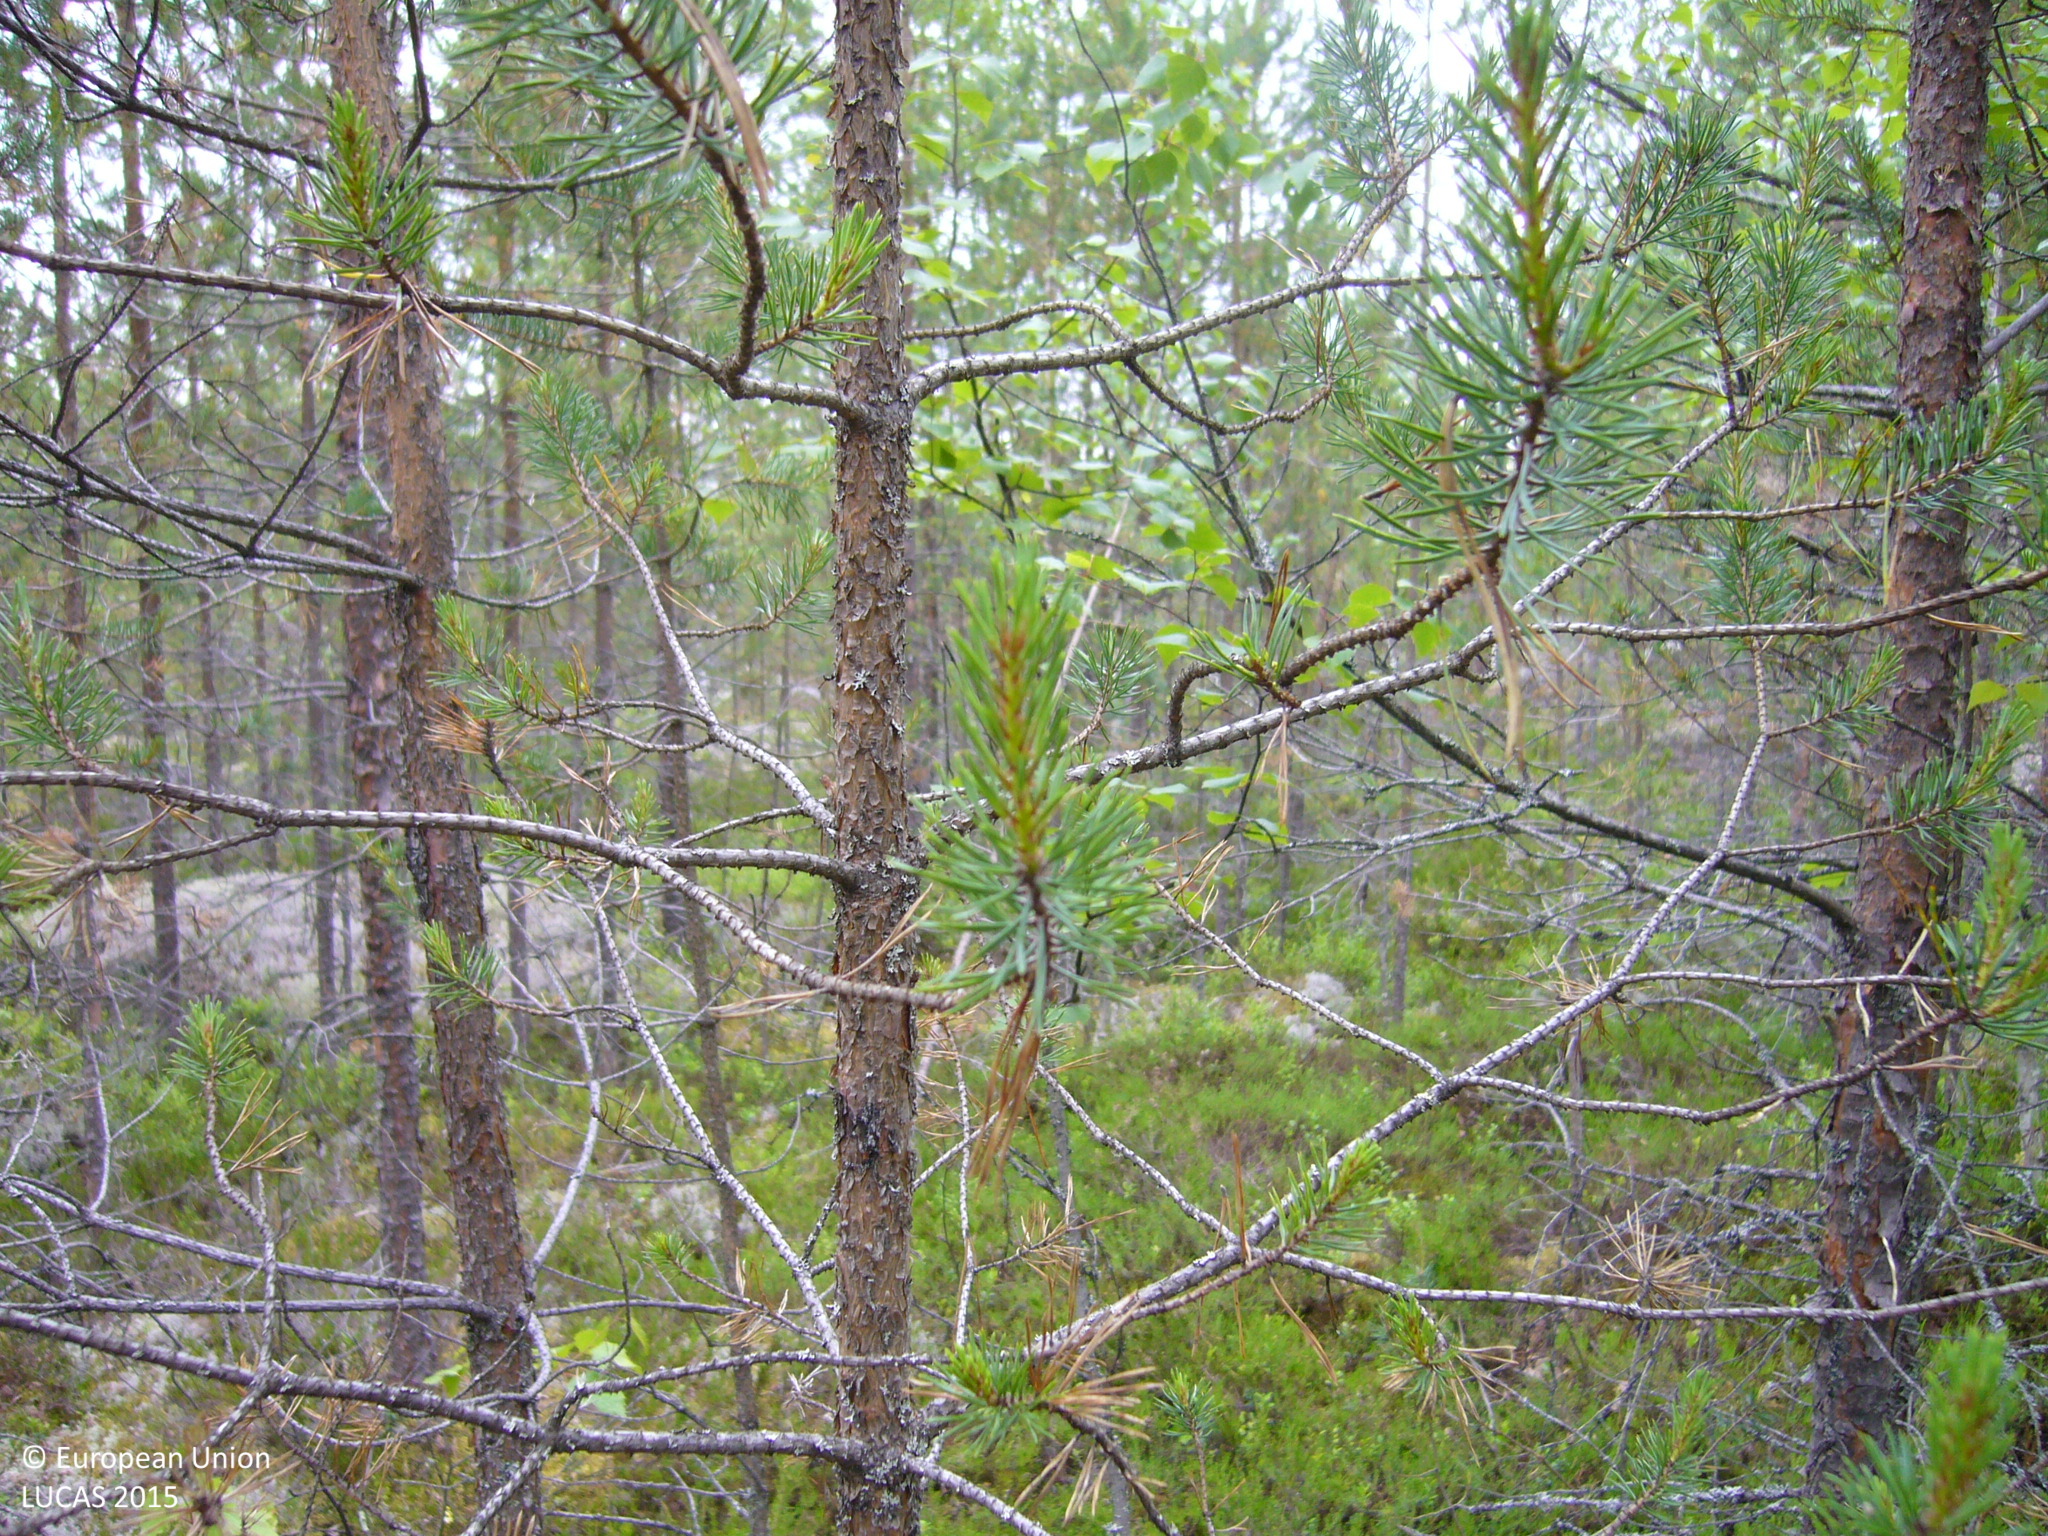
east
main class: Woodland
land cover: Pine dominated coniferous woodland
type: boreal forest
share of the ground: 50 - 75 %
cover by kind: coniferous forest trees 50 %, shrubs 35 %, broadleaved forest trees 15 %
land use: Forestry
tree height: > 5 m
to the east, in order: Pine dominated coniferous woodland
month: July
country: FI
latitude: 63.4191
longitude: 25.7527
